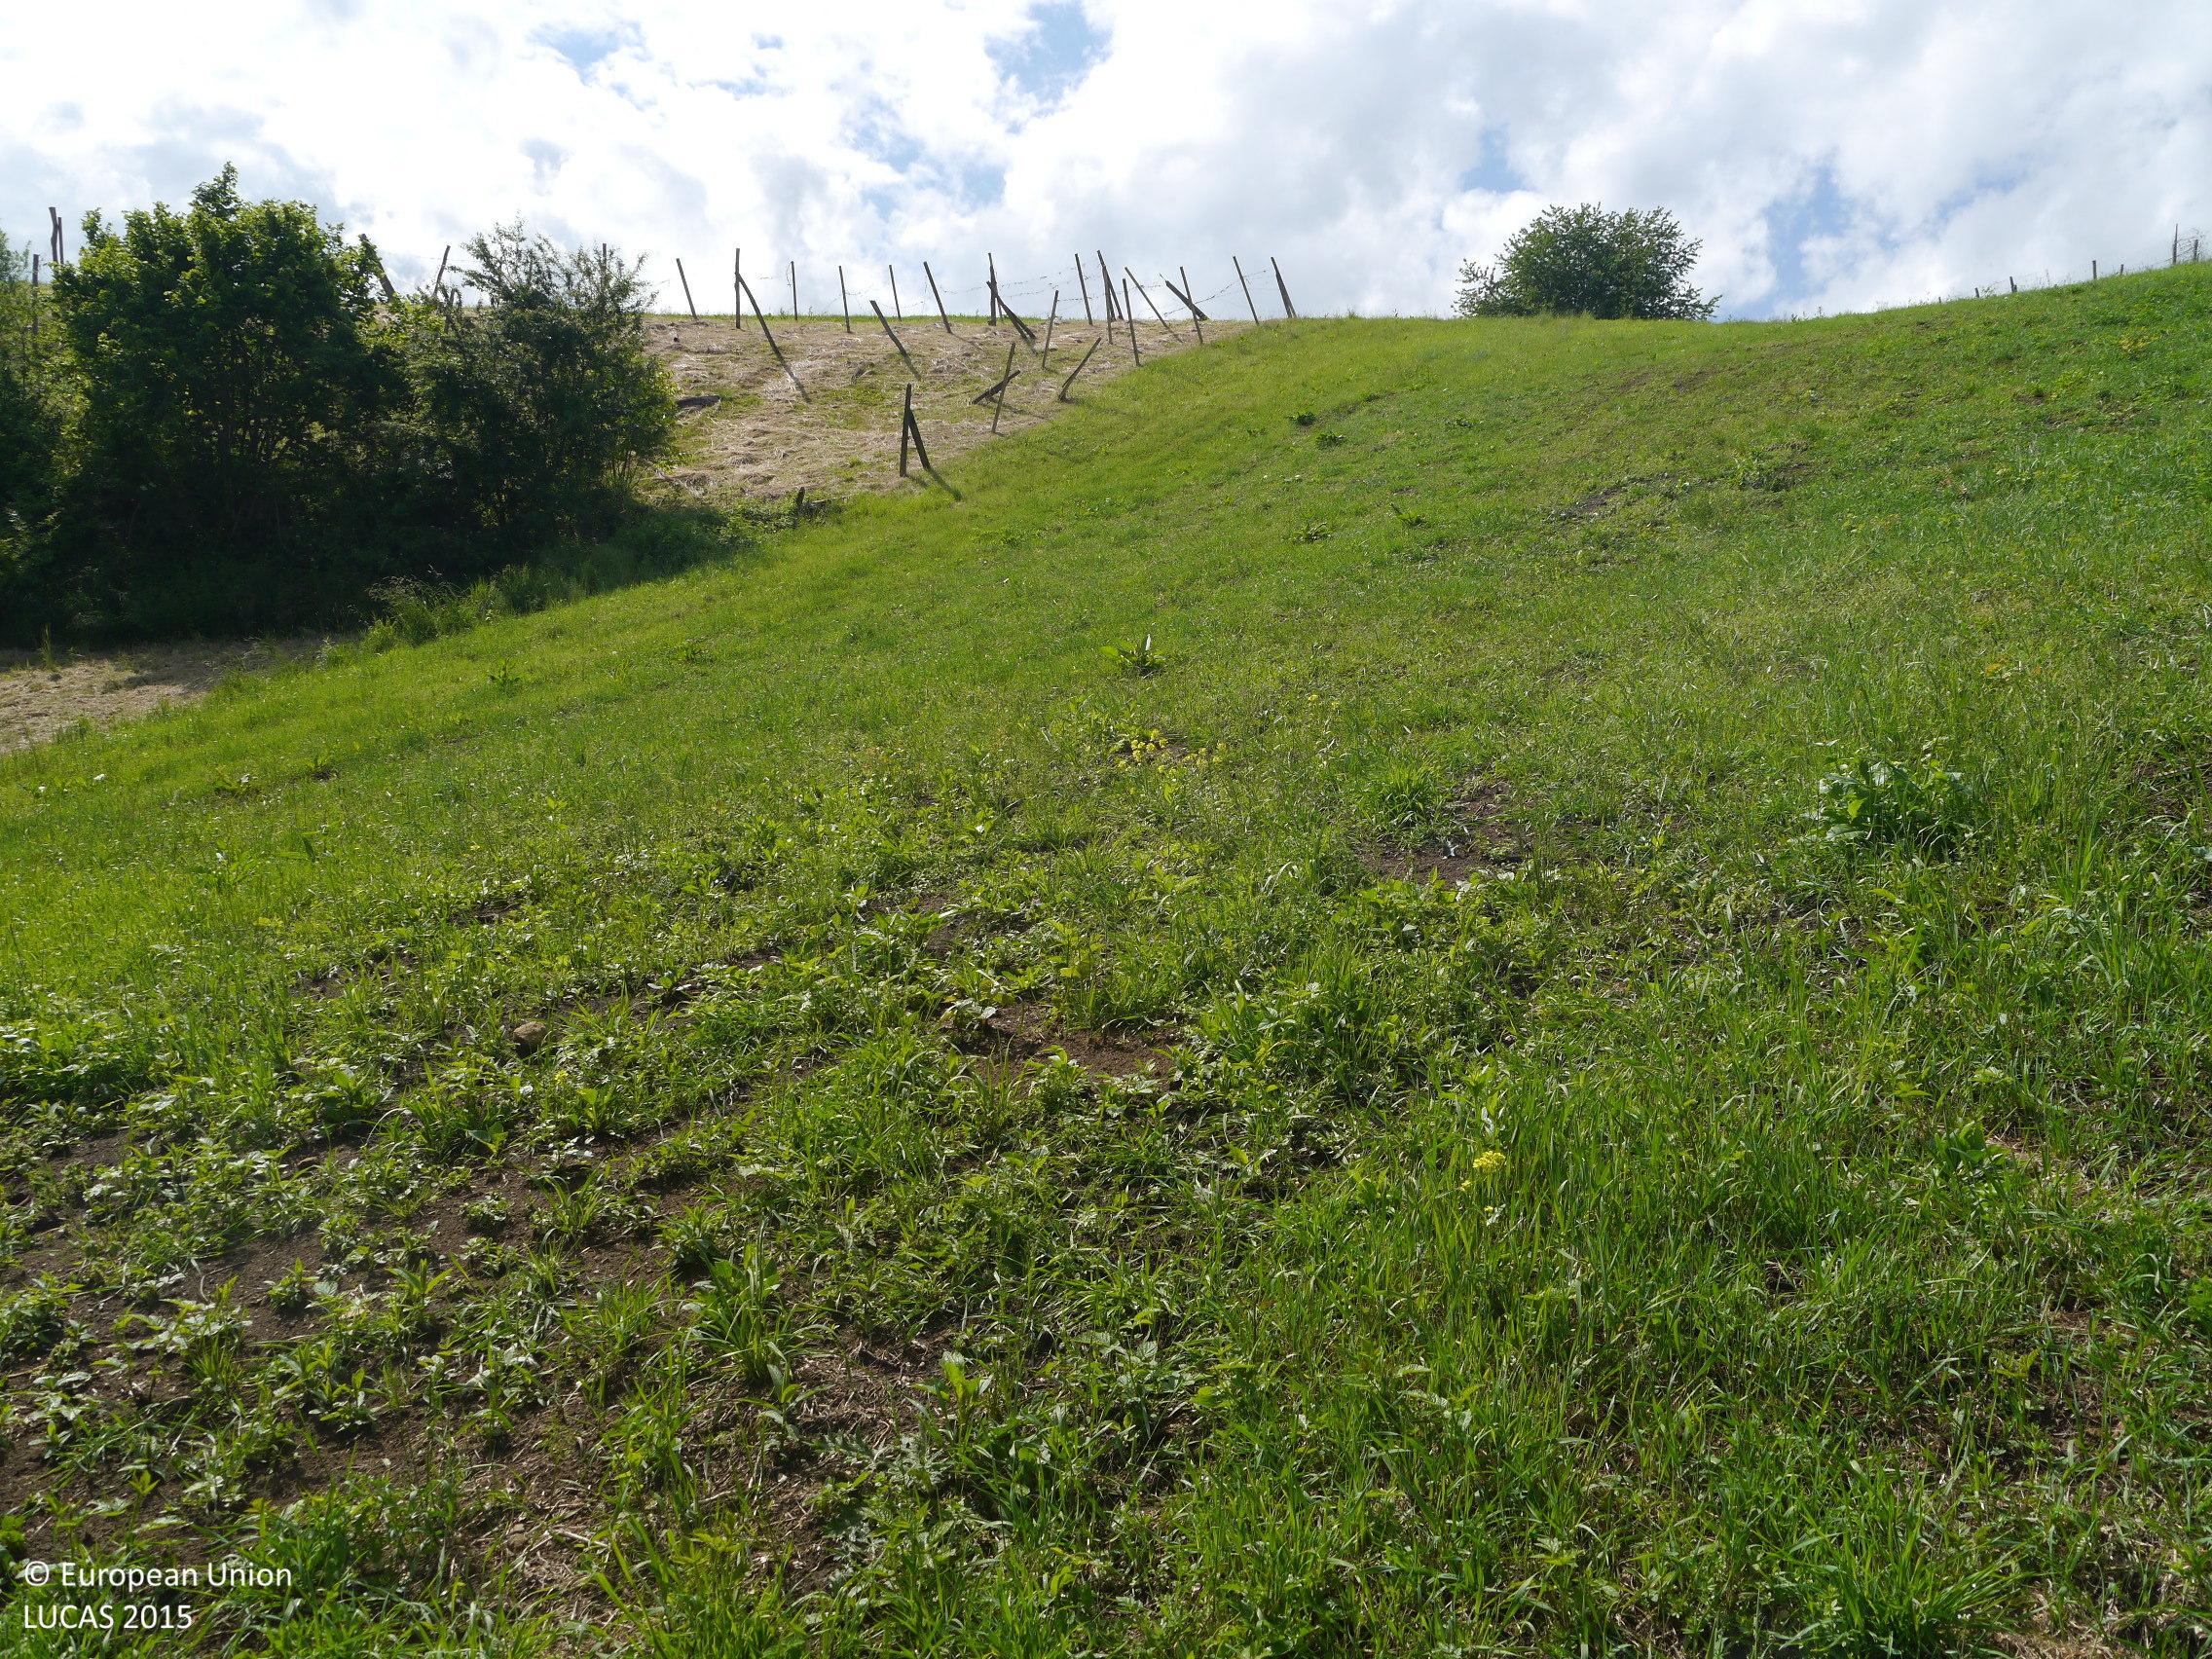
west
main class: Grassland
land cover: Grassland without tree/shrub cover
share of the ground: > 75 %
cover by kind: herbaceous plants 100 %
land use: Agriculture (excluding fallow land and kitchen gardens)
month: May
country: AT
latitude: 46.8735
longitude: 15.9177
